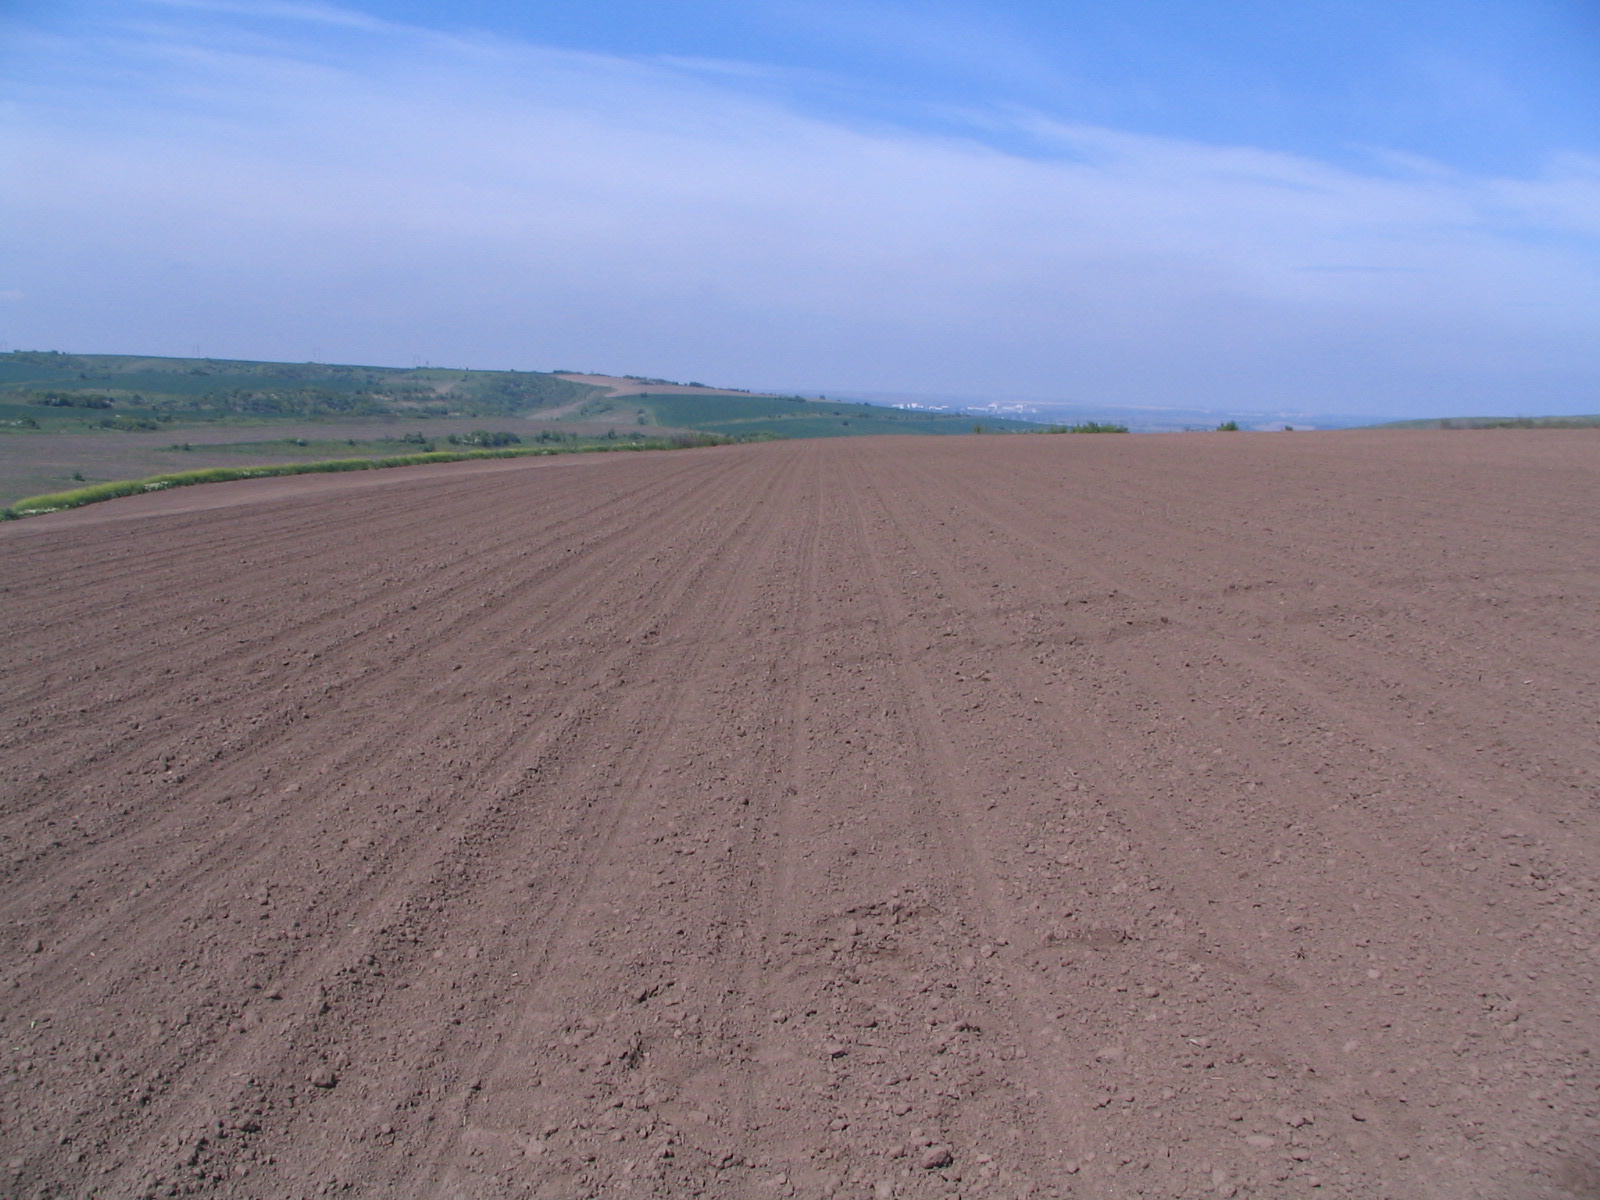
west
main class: Cropland
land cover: Maize
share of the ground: < 10 %
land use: Agriculture (excluding fallow land and kitchen gardens)
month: May
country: BG
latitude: 43.7181
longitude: 23.9179
